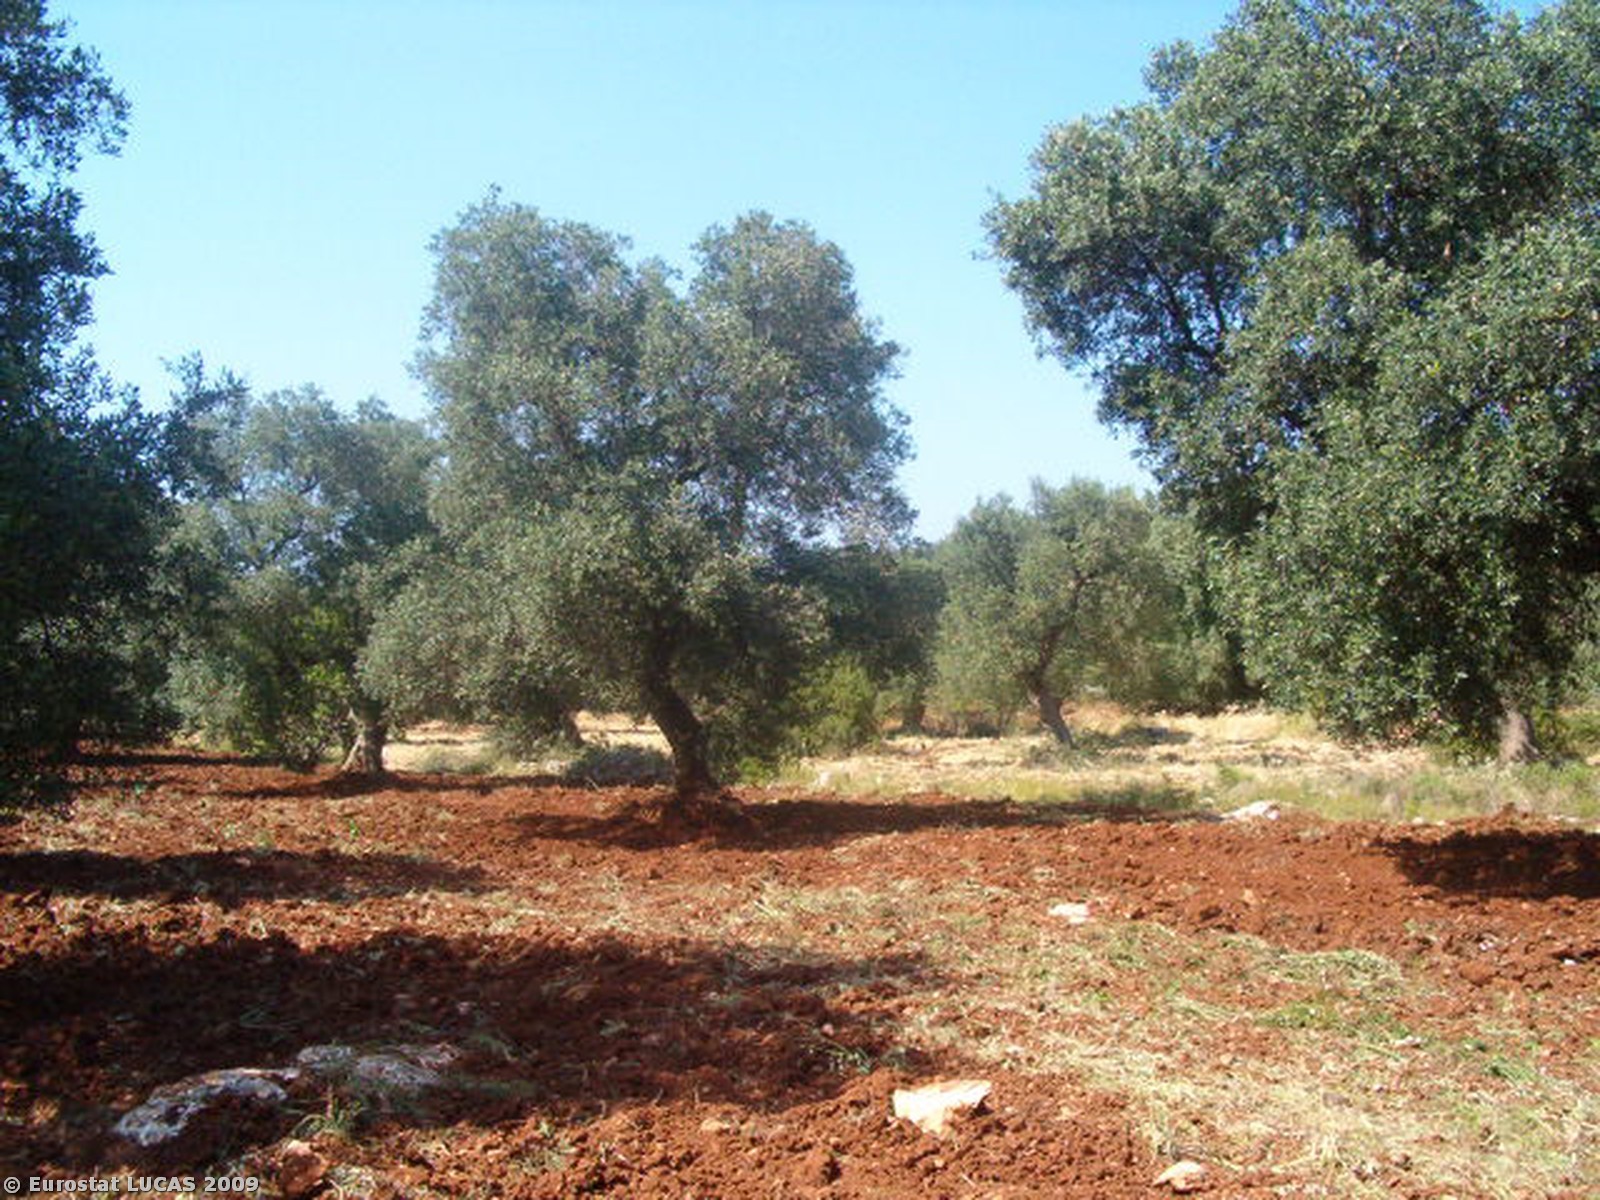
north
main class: Cropland
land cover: Olive groves
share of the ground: 25 - 50 %
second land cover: Bare land
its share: > 75 %
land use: Agriculture (excluding fallow land and kitchen gardens)
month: May
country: IT
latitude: 40.6980
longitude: 17.6105
